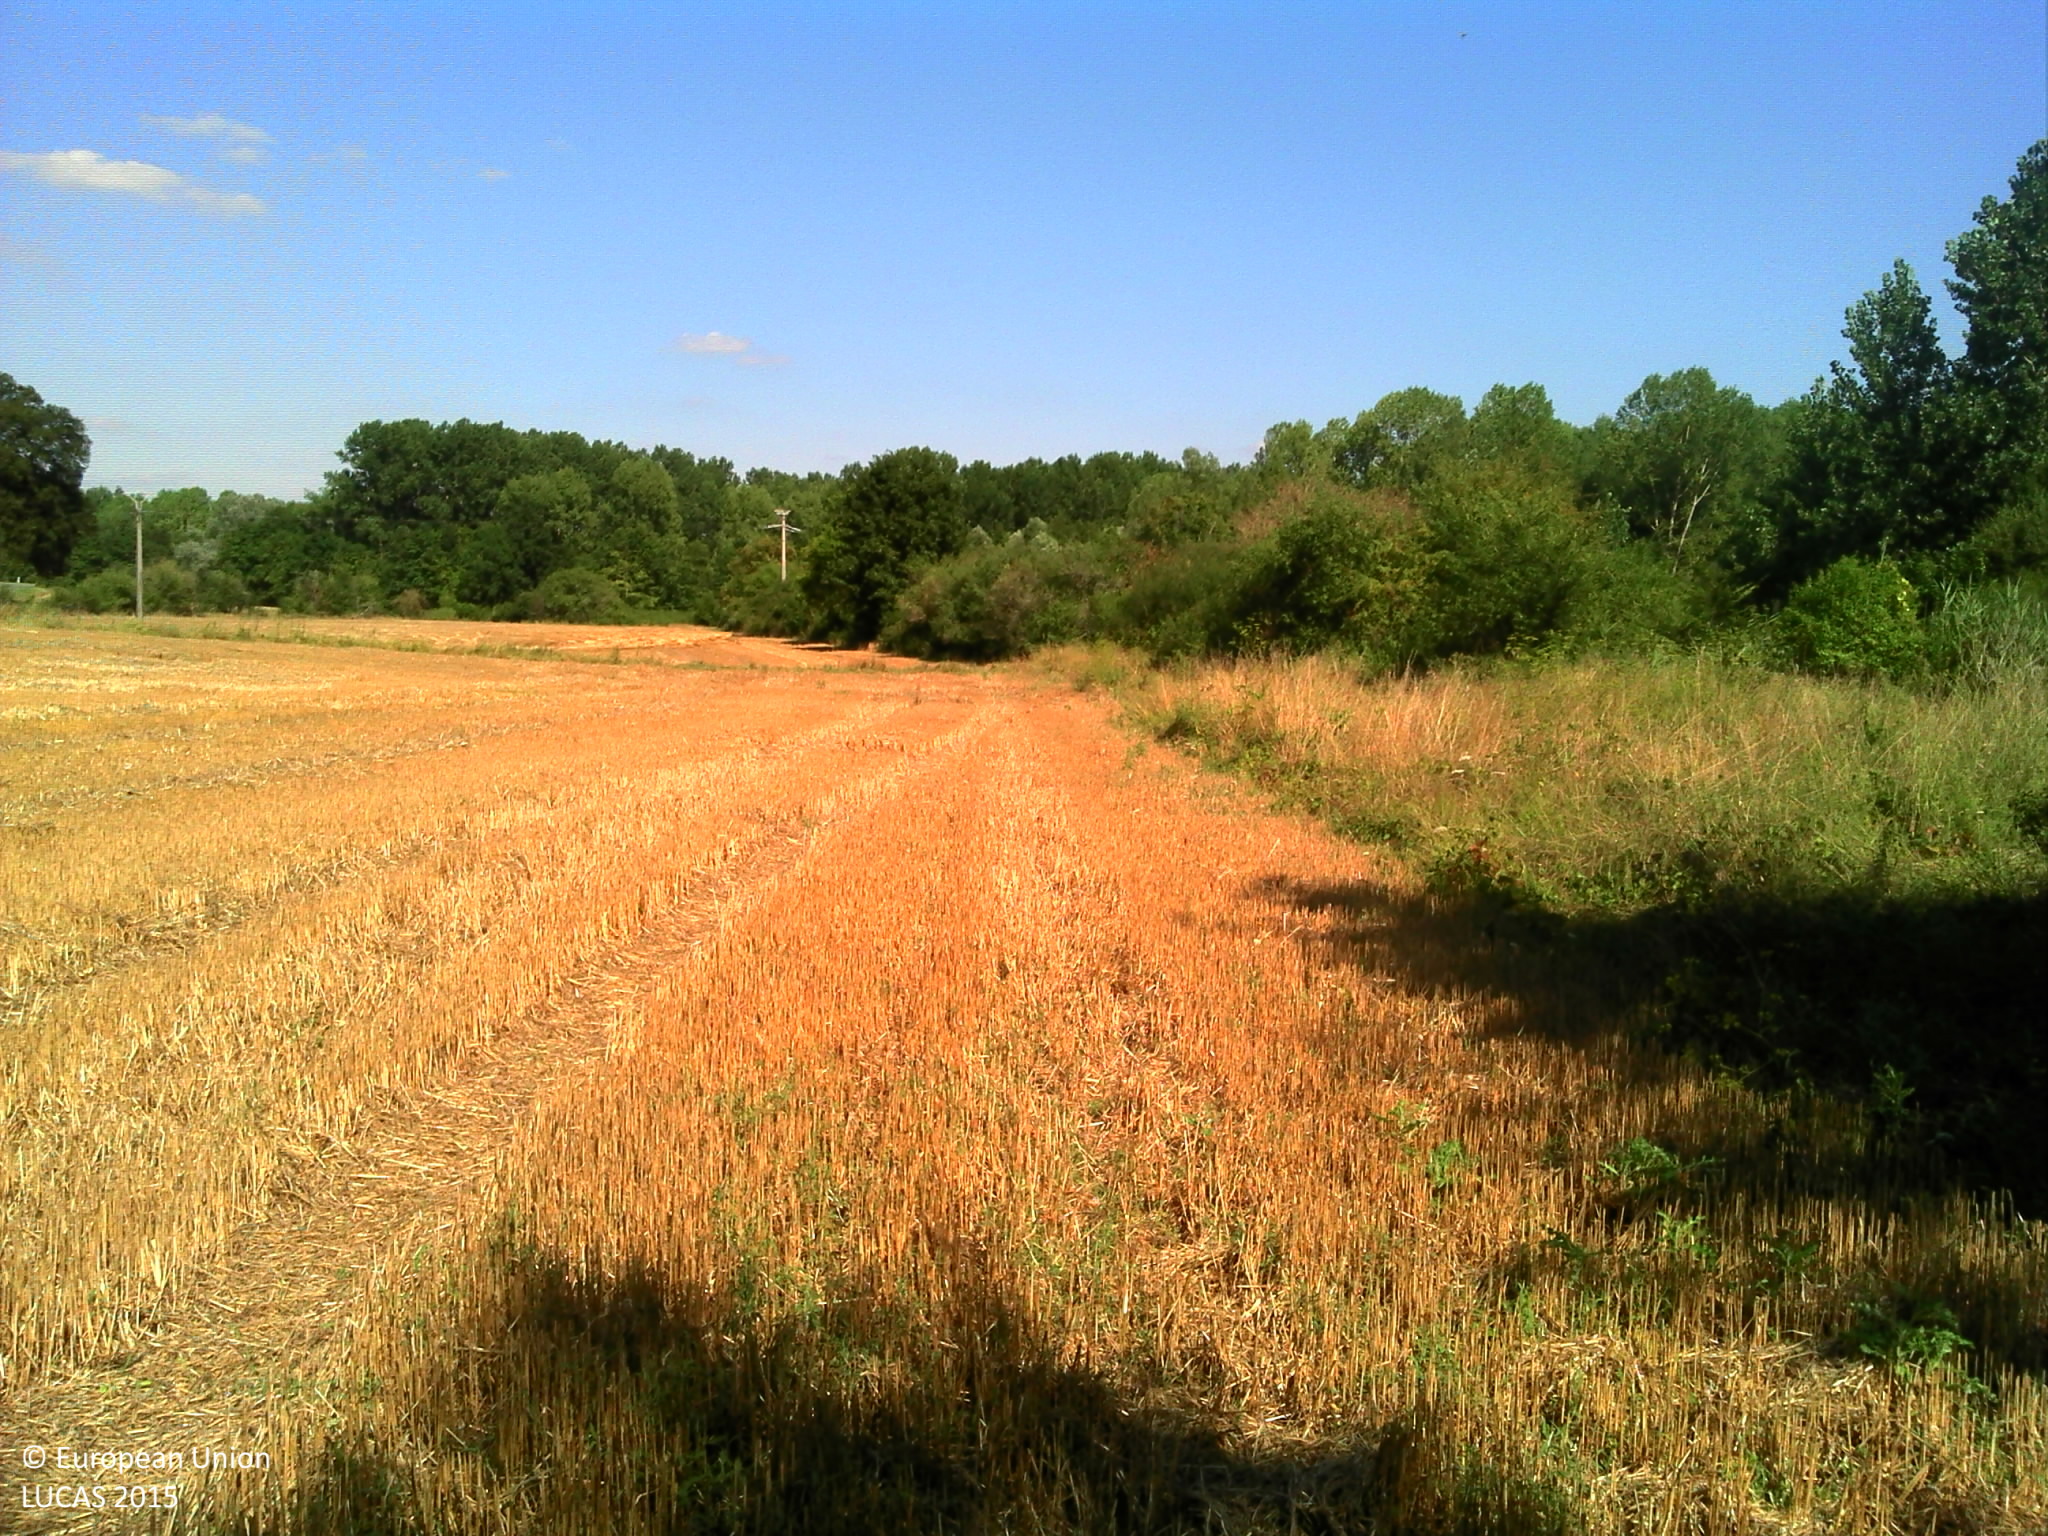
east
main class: Cropland
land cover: Common wheat
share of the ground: 10 - 25 %
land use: Agriculture (excluding fallow land and kitchen gardens)
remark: Harvested field
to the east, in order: Common wheat; Tracks; Groves; Electric lines; Grassland without tree/shrub cover
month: August
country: FR
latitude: 45.2988
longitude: 0.7700
